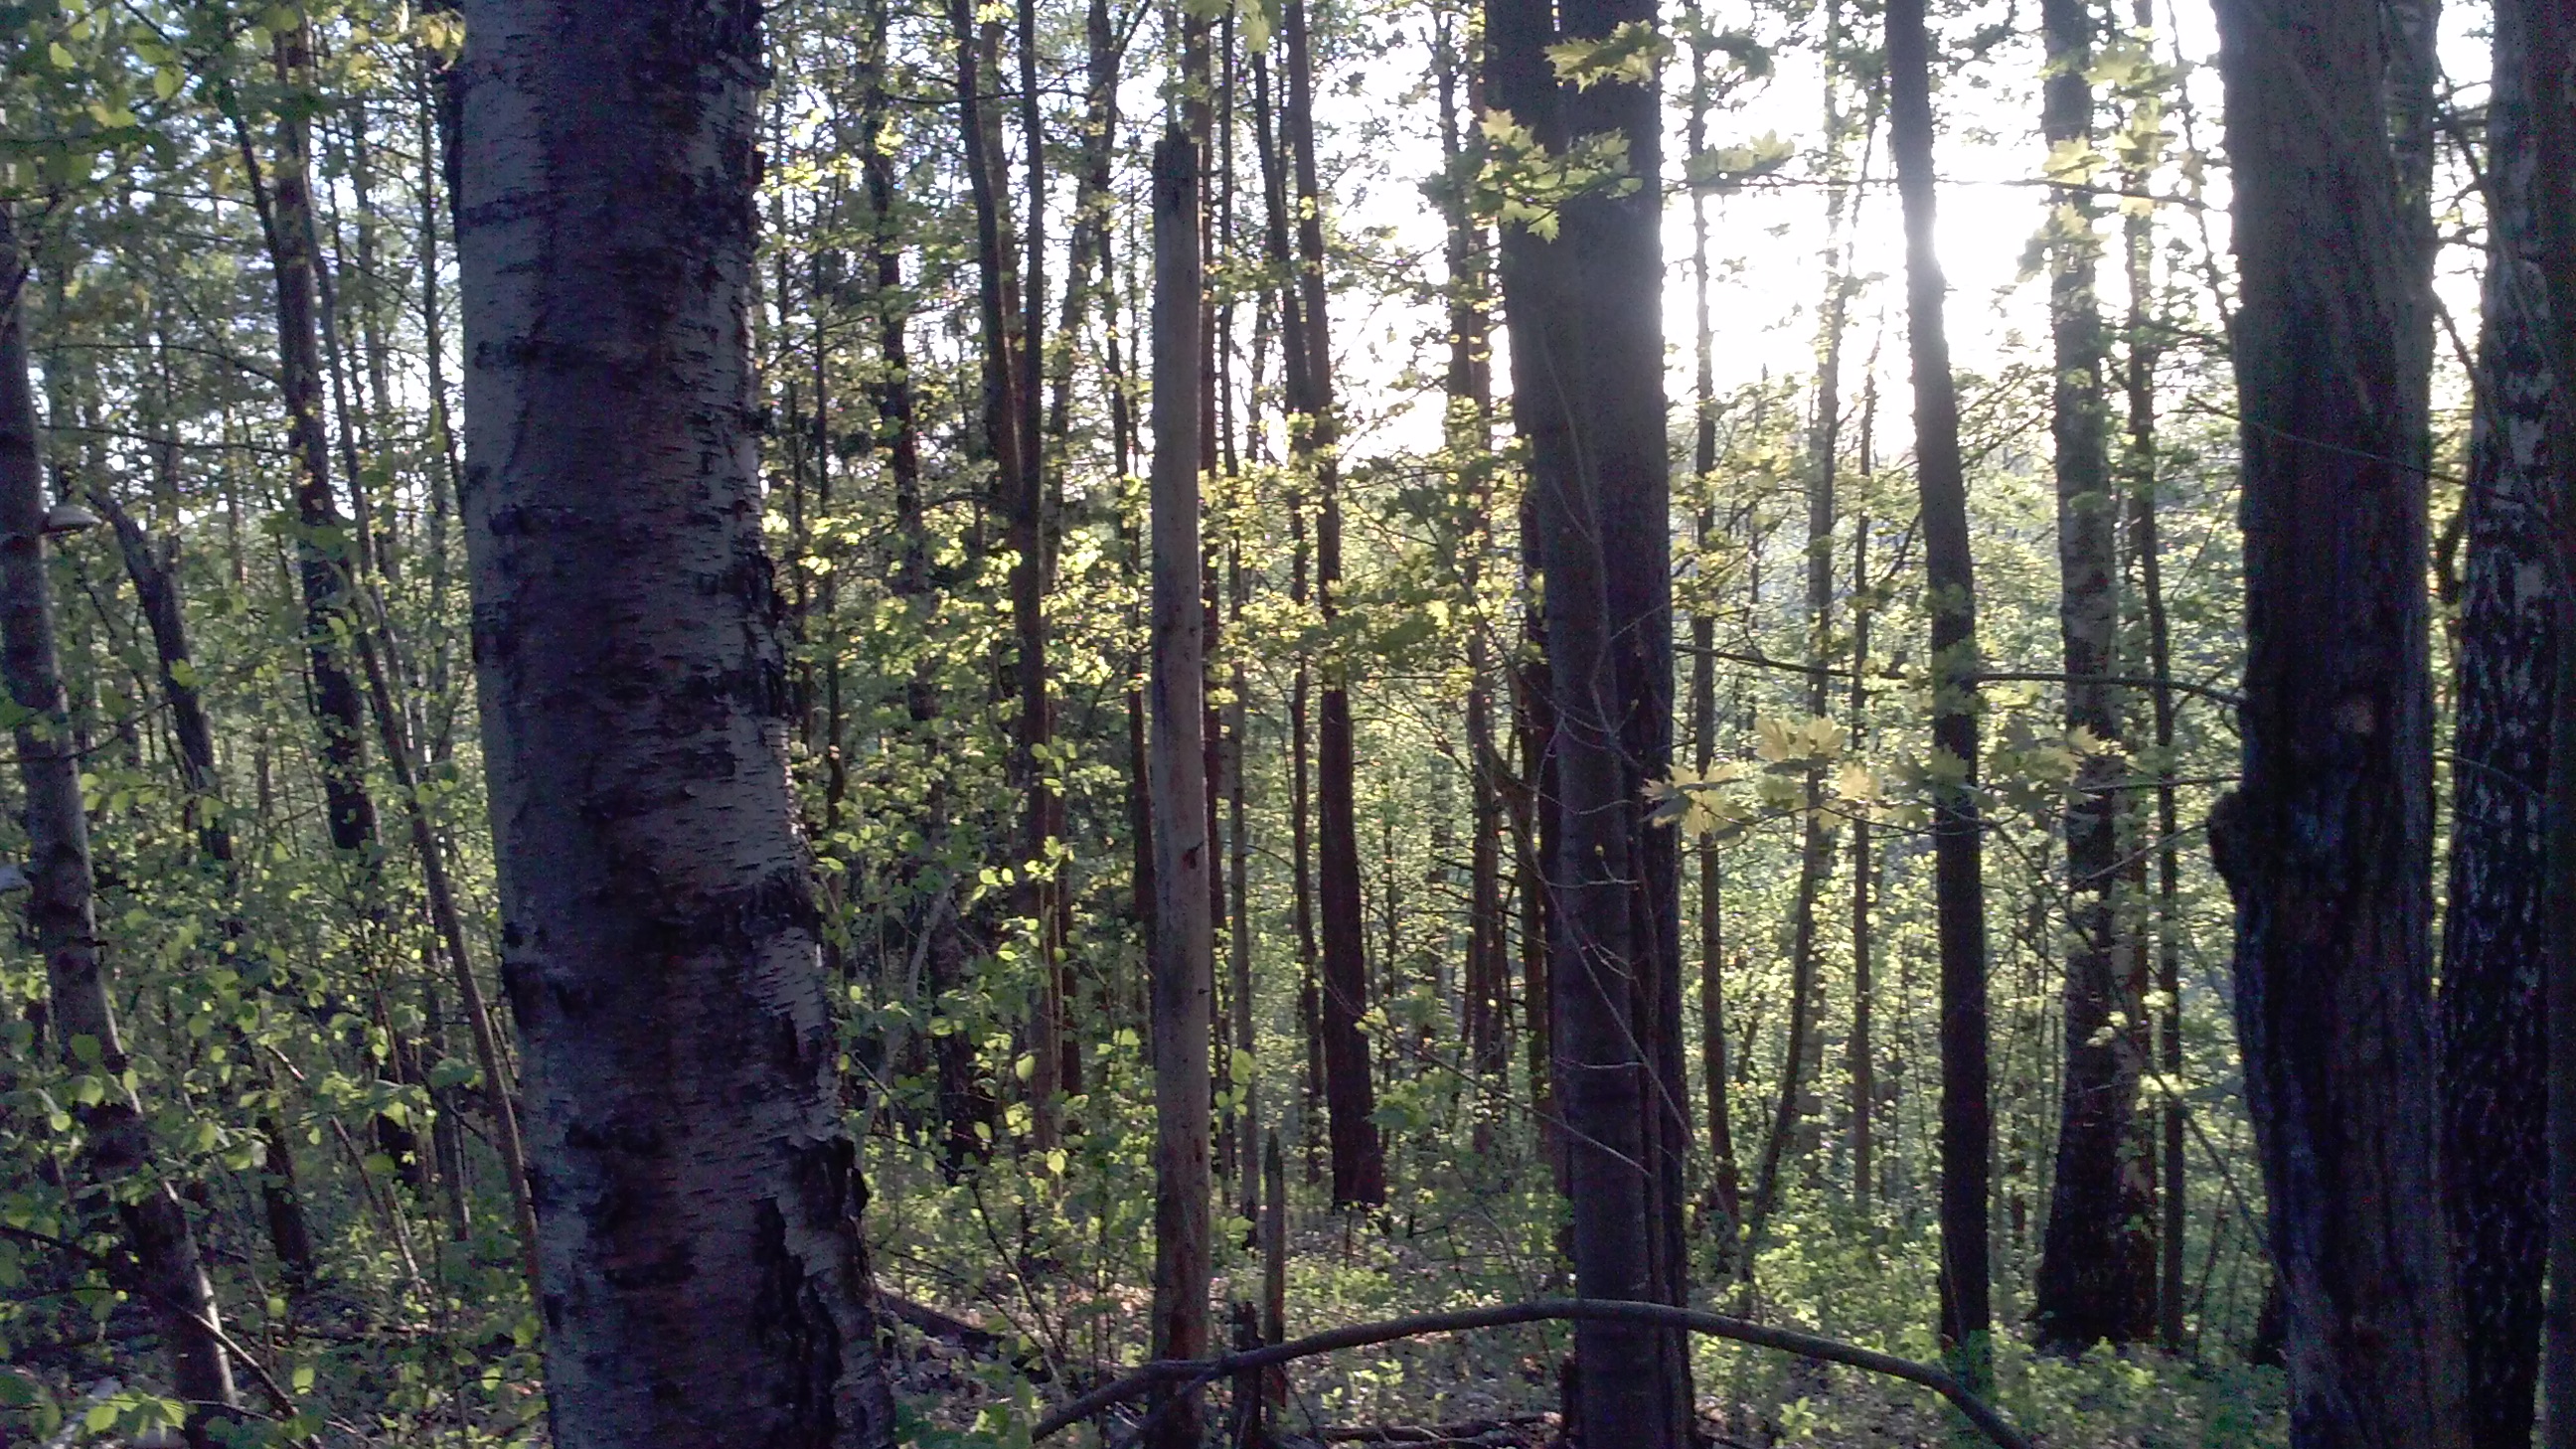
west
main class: Woodland
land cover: Broadleaved woodland
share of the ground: > 75 %
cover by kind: broadleaved forest trees 100 %
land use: Forestry
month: May
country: LV
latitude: 56.0795
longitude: 27.2200
